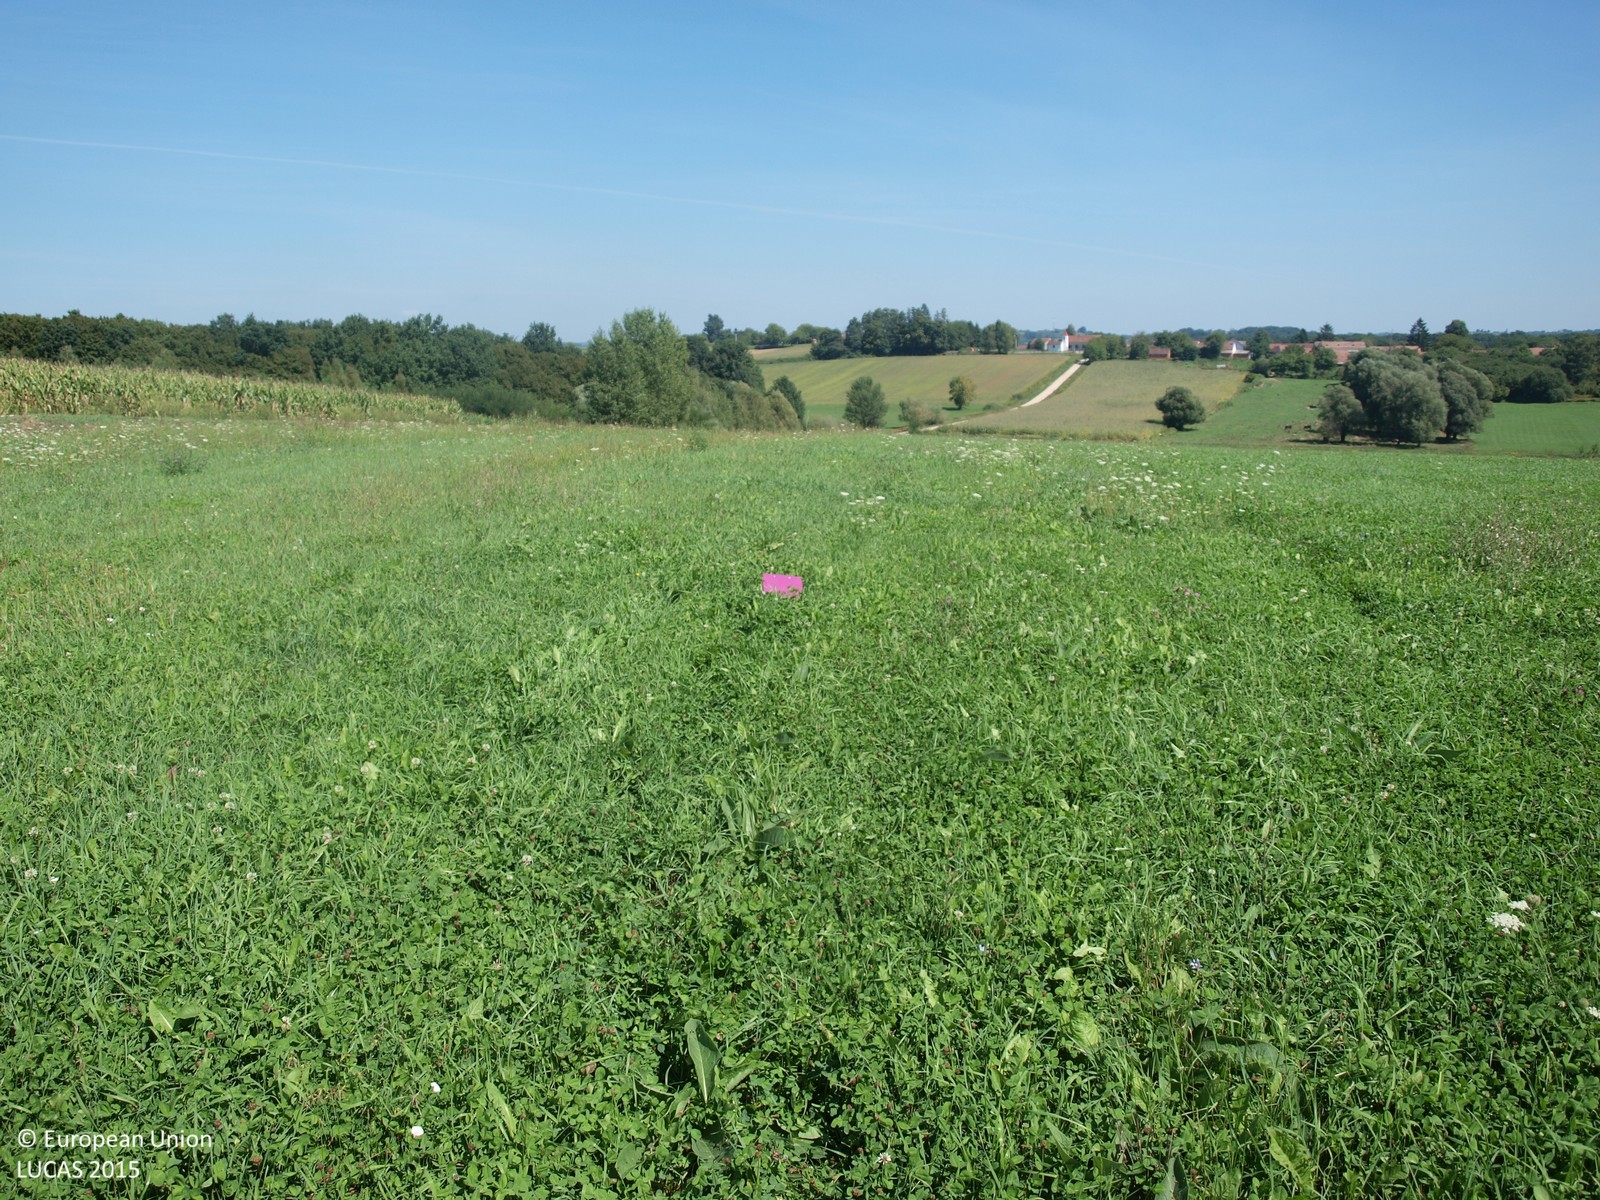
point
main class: Grassland
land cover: Grassland without tree/shrub cover
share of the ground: > 75 %
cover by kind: herbaceous plants 100 %
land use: Agriculture (excluding fallow land and kitchen gardens)
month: August
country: HR
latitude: 46.0143
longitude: 16.7036
